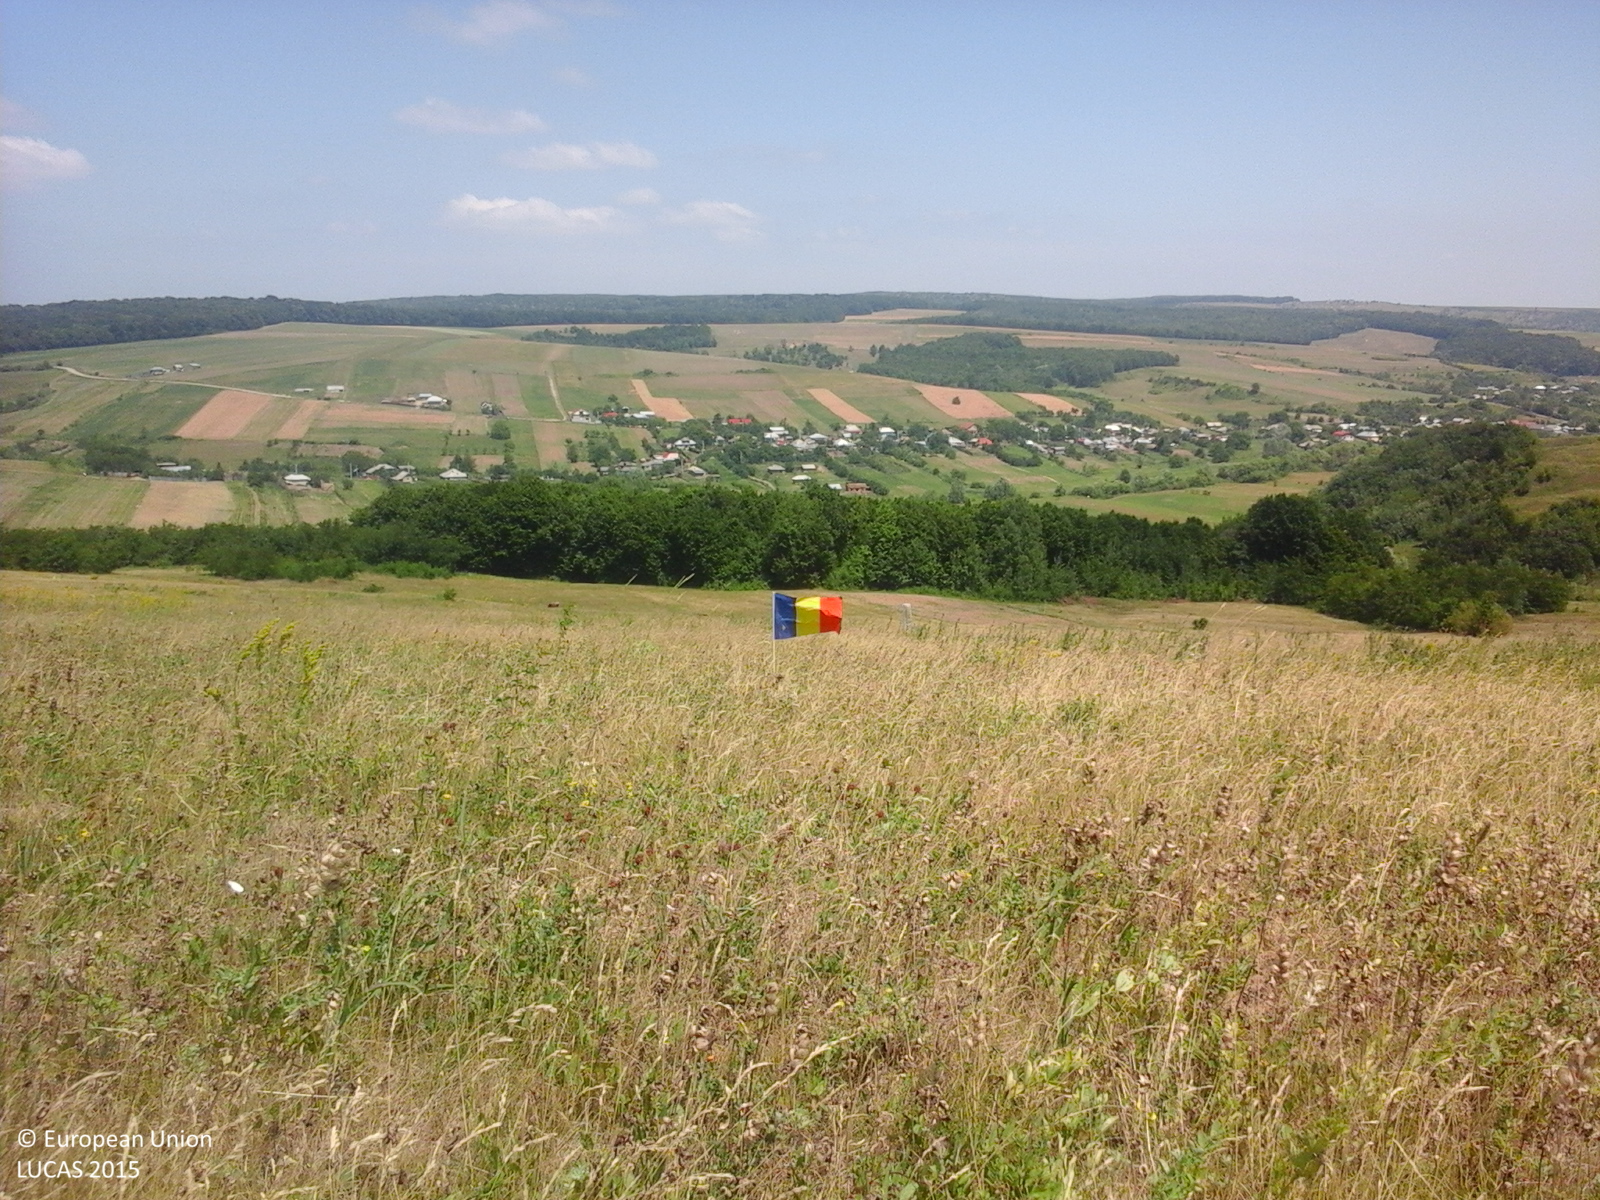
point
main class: Grassland
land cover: Grassland without tree/shrub cover
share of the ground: > 75 %
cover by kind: herbaceous plants 100 %
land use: Agriculture (excluding fallow land and kitchen gardens)
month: June
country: RO
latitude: 46.7365
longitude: 27.1546
